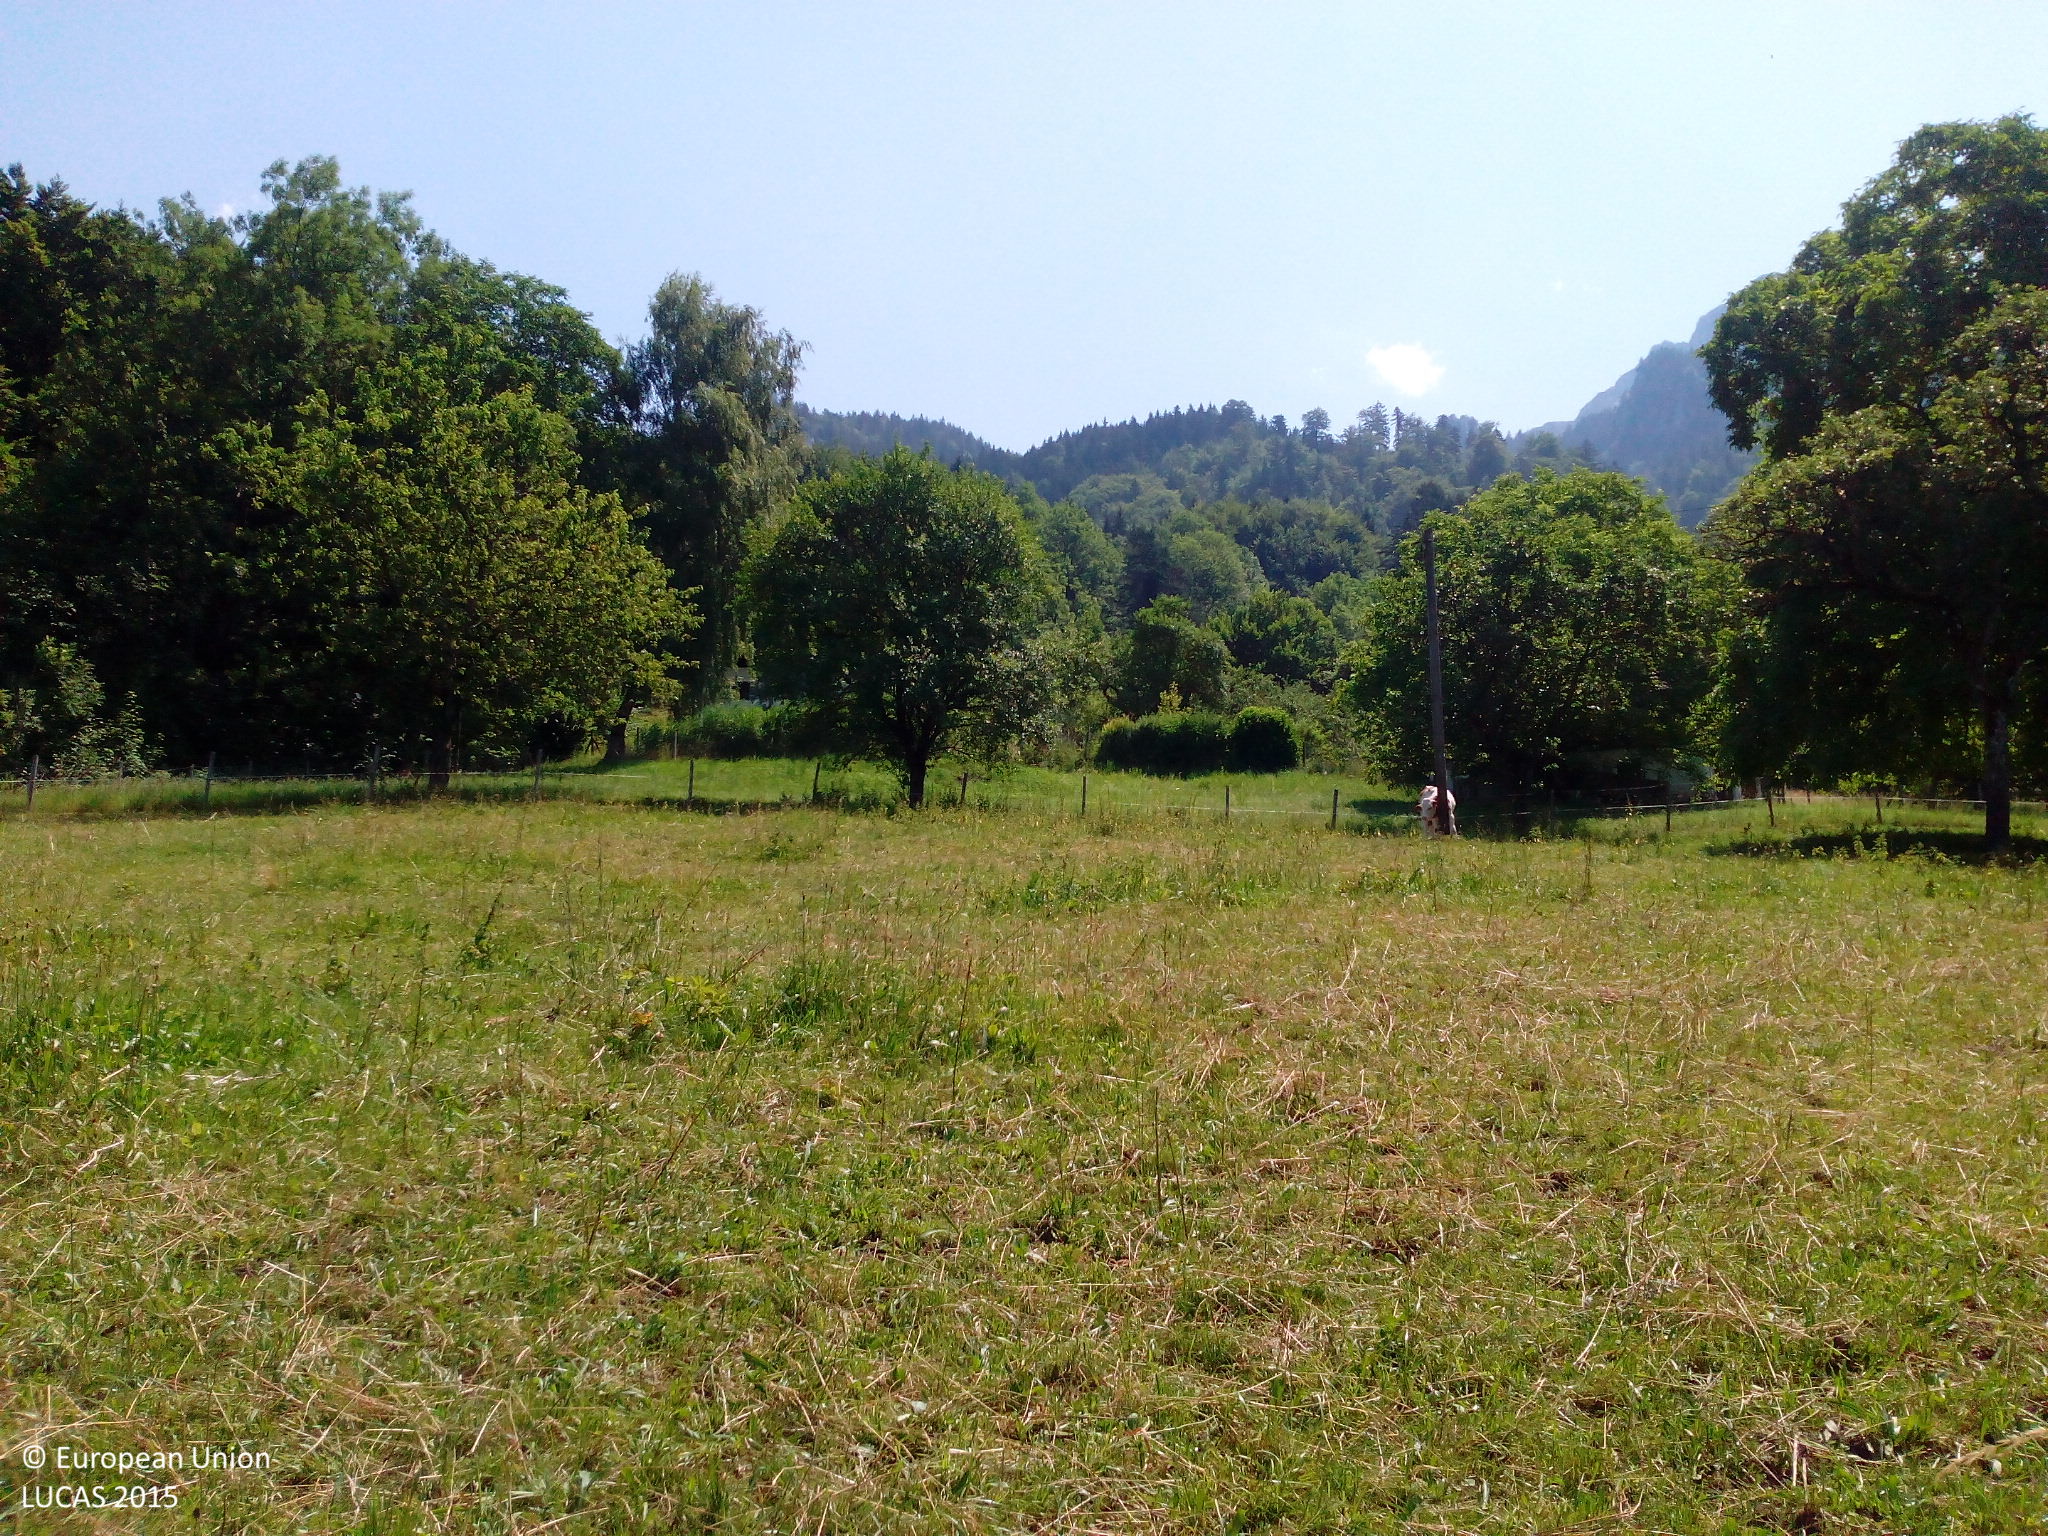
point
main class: Grassland
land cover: Grassland without tree/shrub cover
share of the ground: > 75 %
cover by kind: herbaceous plants 100 %
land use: Agriculture (excluding fallow land and kitchen gardens)
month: July
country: DE
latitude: 47.7668
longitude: 12.3336
